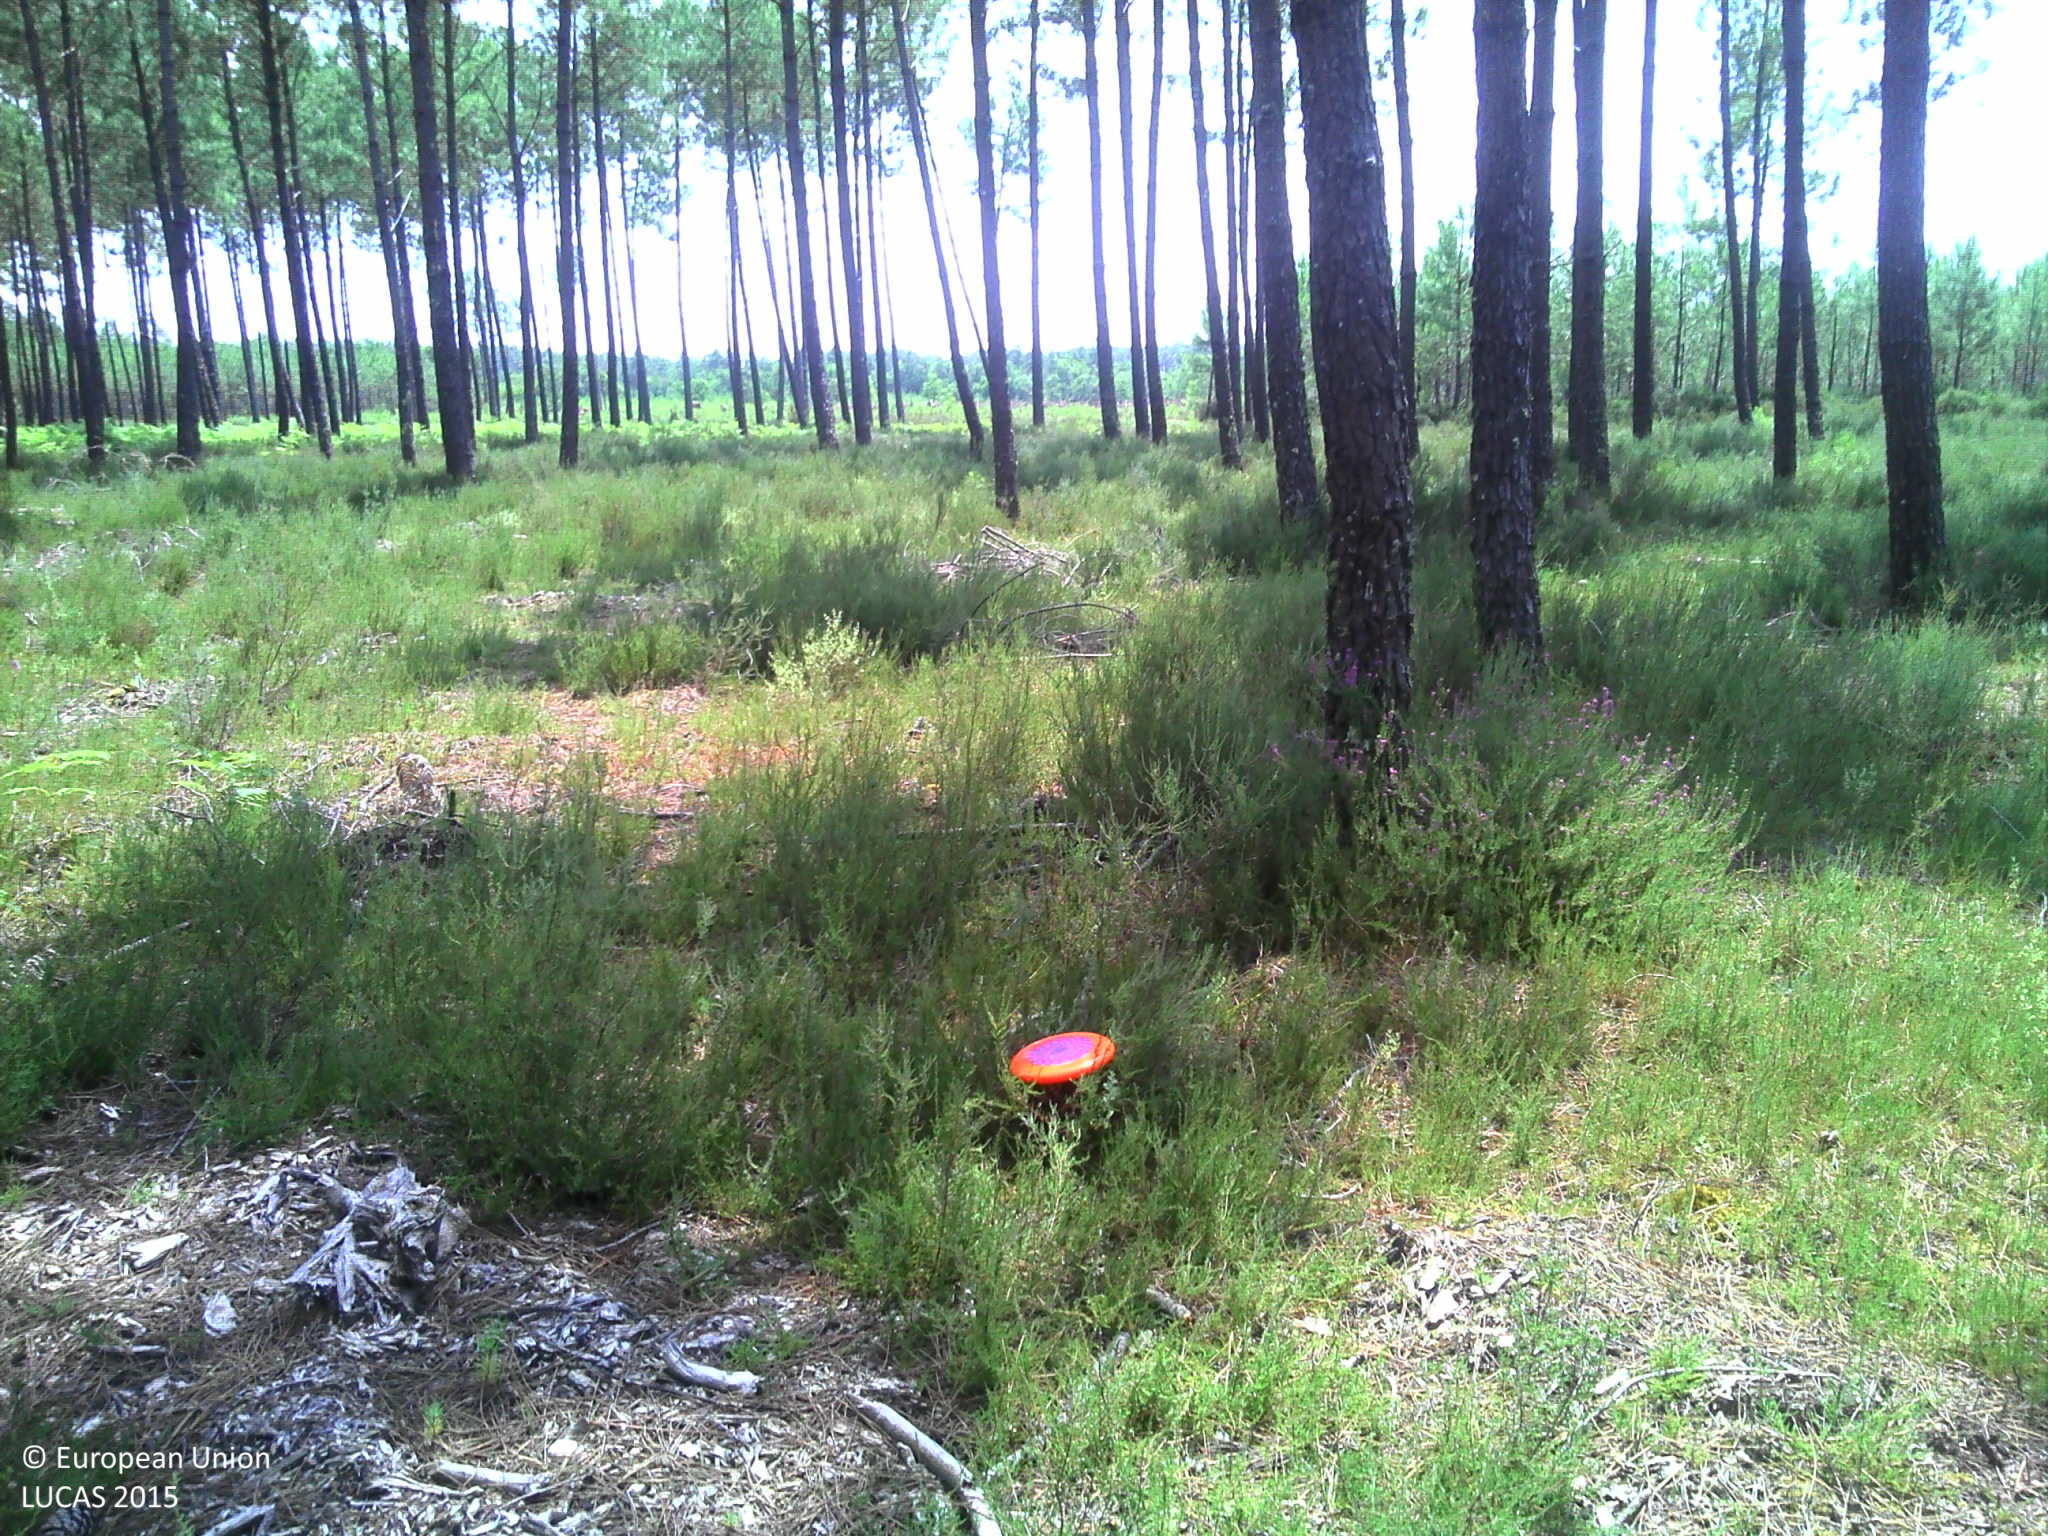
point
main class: Woodland
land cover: Pine dominated coniferous woodland
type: coniferous forest of the mediterranean region
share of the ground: > 75 %
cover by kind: coniferous forest trees 85 %, herbaceous plants 10 %, broadleaved forest trees 5 %
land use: Forestry
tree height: > 5 m
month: July
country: FR
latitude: 43.8281
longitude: -1.2473
